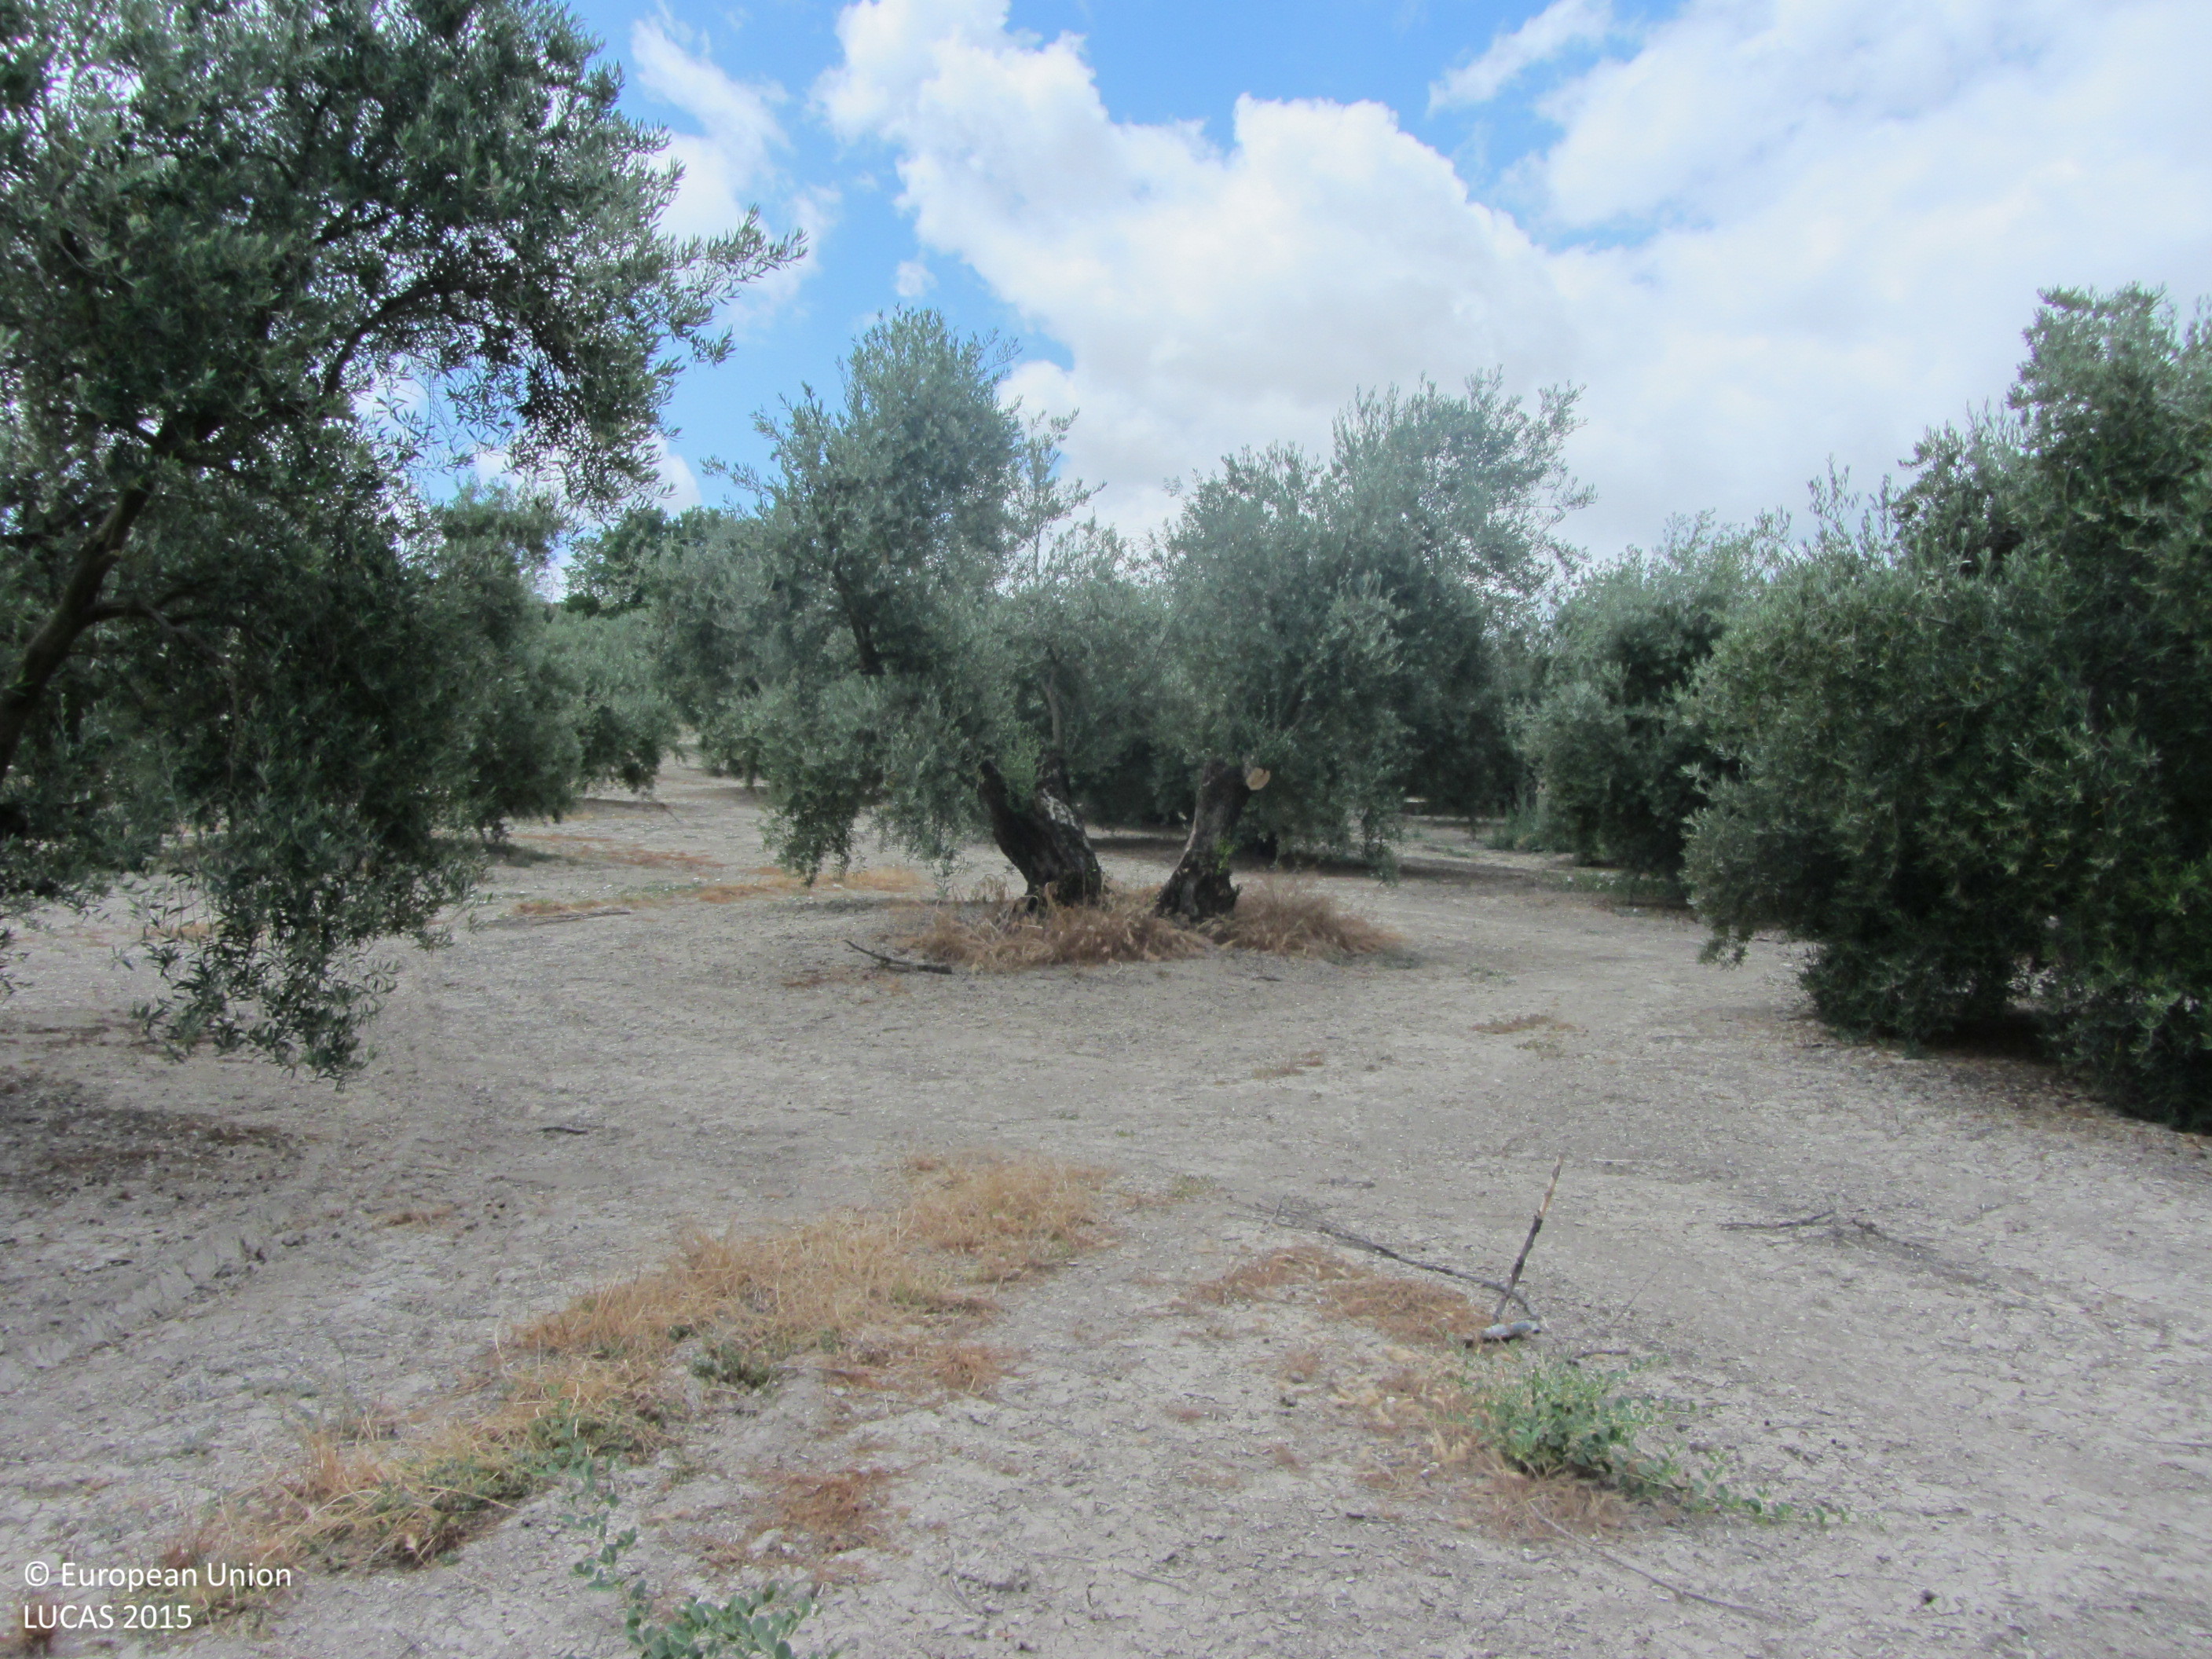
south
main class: Cropland
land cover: Olive groves
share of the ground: 25 - 50 %
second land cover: Other bare soil
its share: > 75 %
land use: Agriculture (excluding fallow land and kitchen gardens)
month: June
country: ES
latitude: 38.1380
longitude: -3.1088
